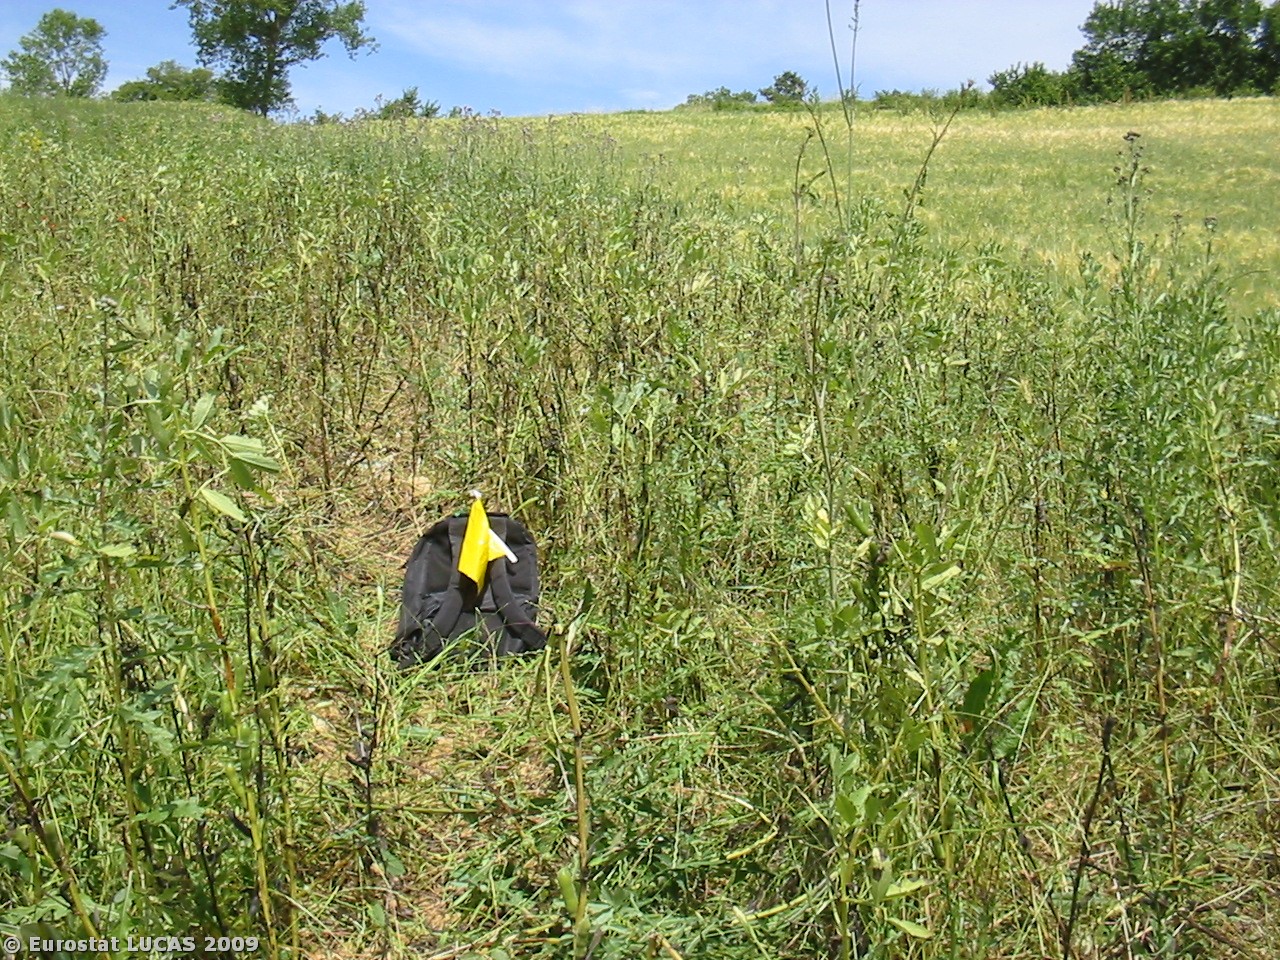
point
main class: Cropland
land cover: Dry pulses
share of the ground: > 75 %
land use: Agriculture (excluding fallow land and kitchen gardens)
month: June
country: IT
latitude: 42.9586
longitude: 12.0410
